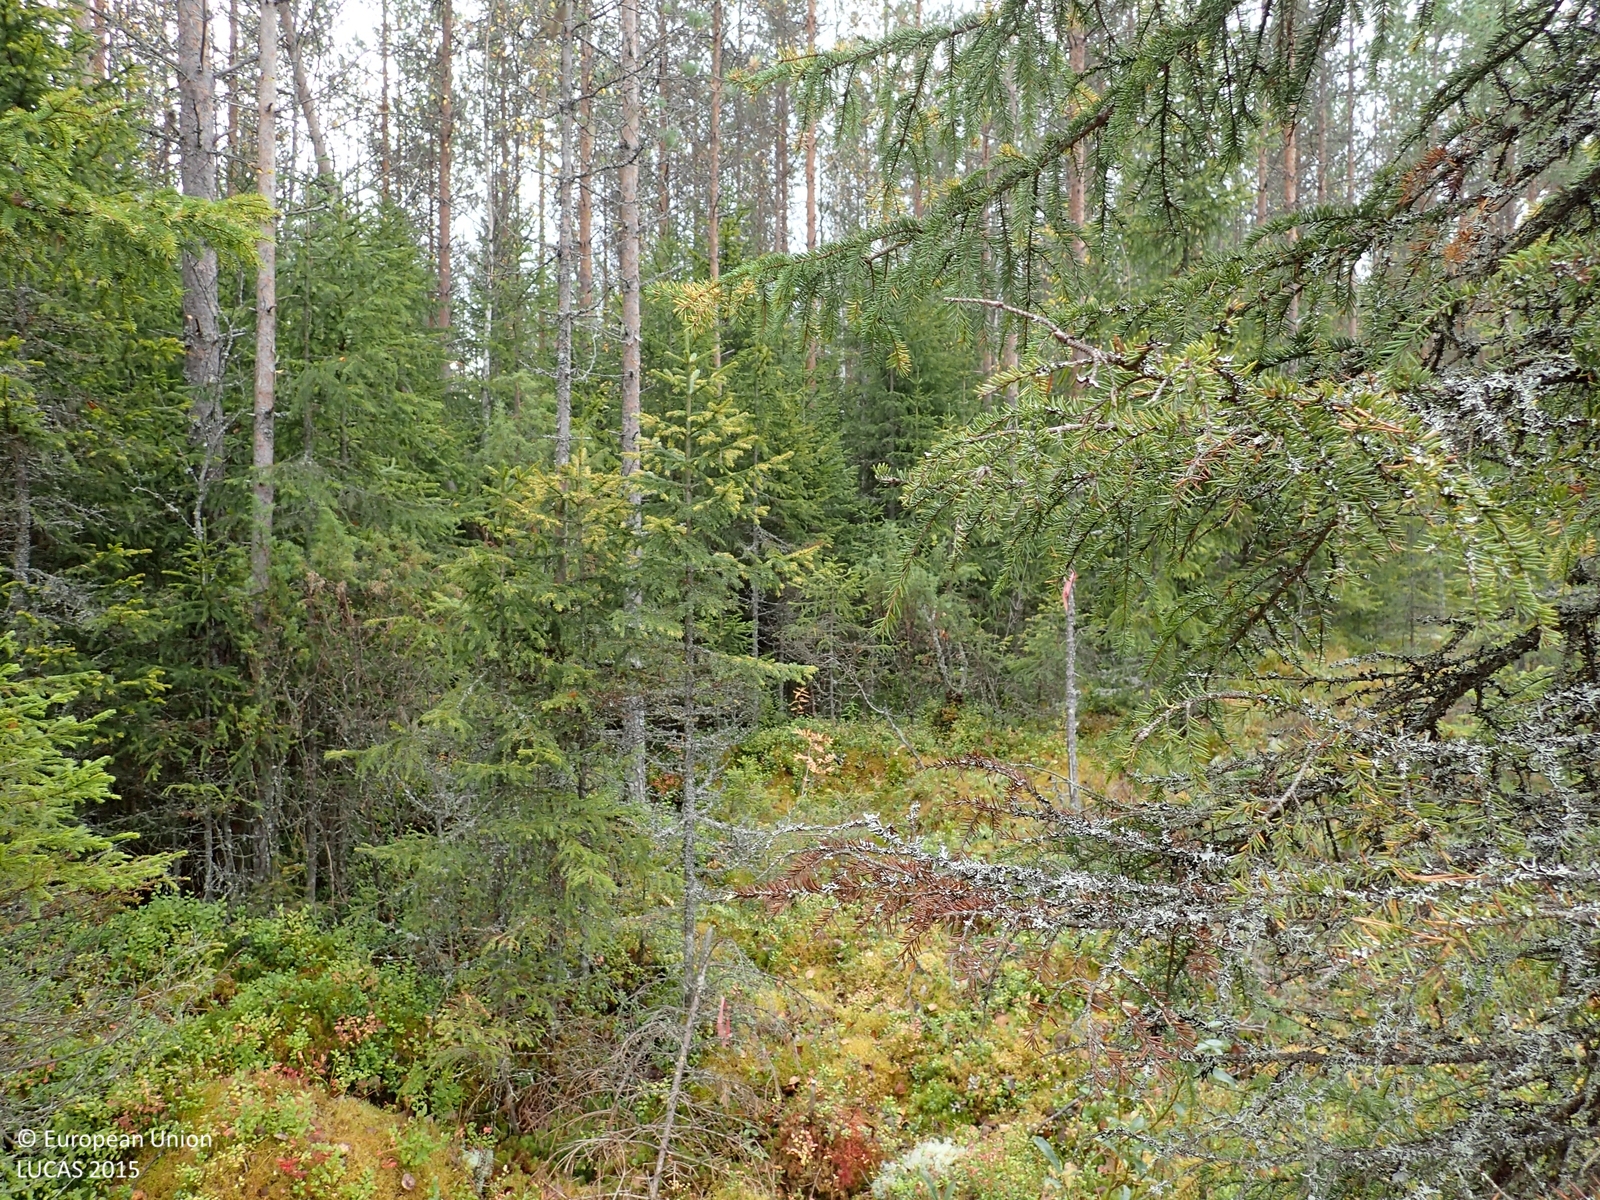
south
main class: Woodland
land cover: Spruce dominated coniferous woodland
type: boreal forest
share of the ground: 50 - 75 %
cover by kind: coniferous forest trees 50 %, shrubs 45 %, lichens and mosses 5 %
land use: Forestry
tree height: < 5 m
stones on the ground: < 10 %
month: September
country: FI
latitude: 63.2874
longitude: 25.2319
